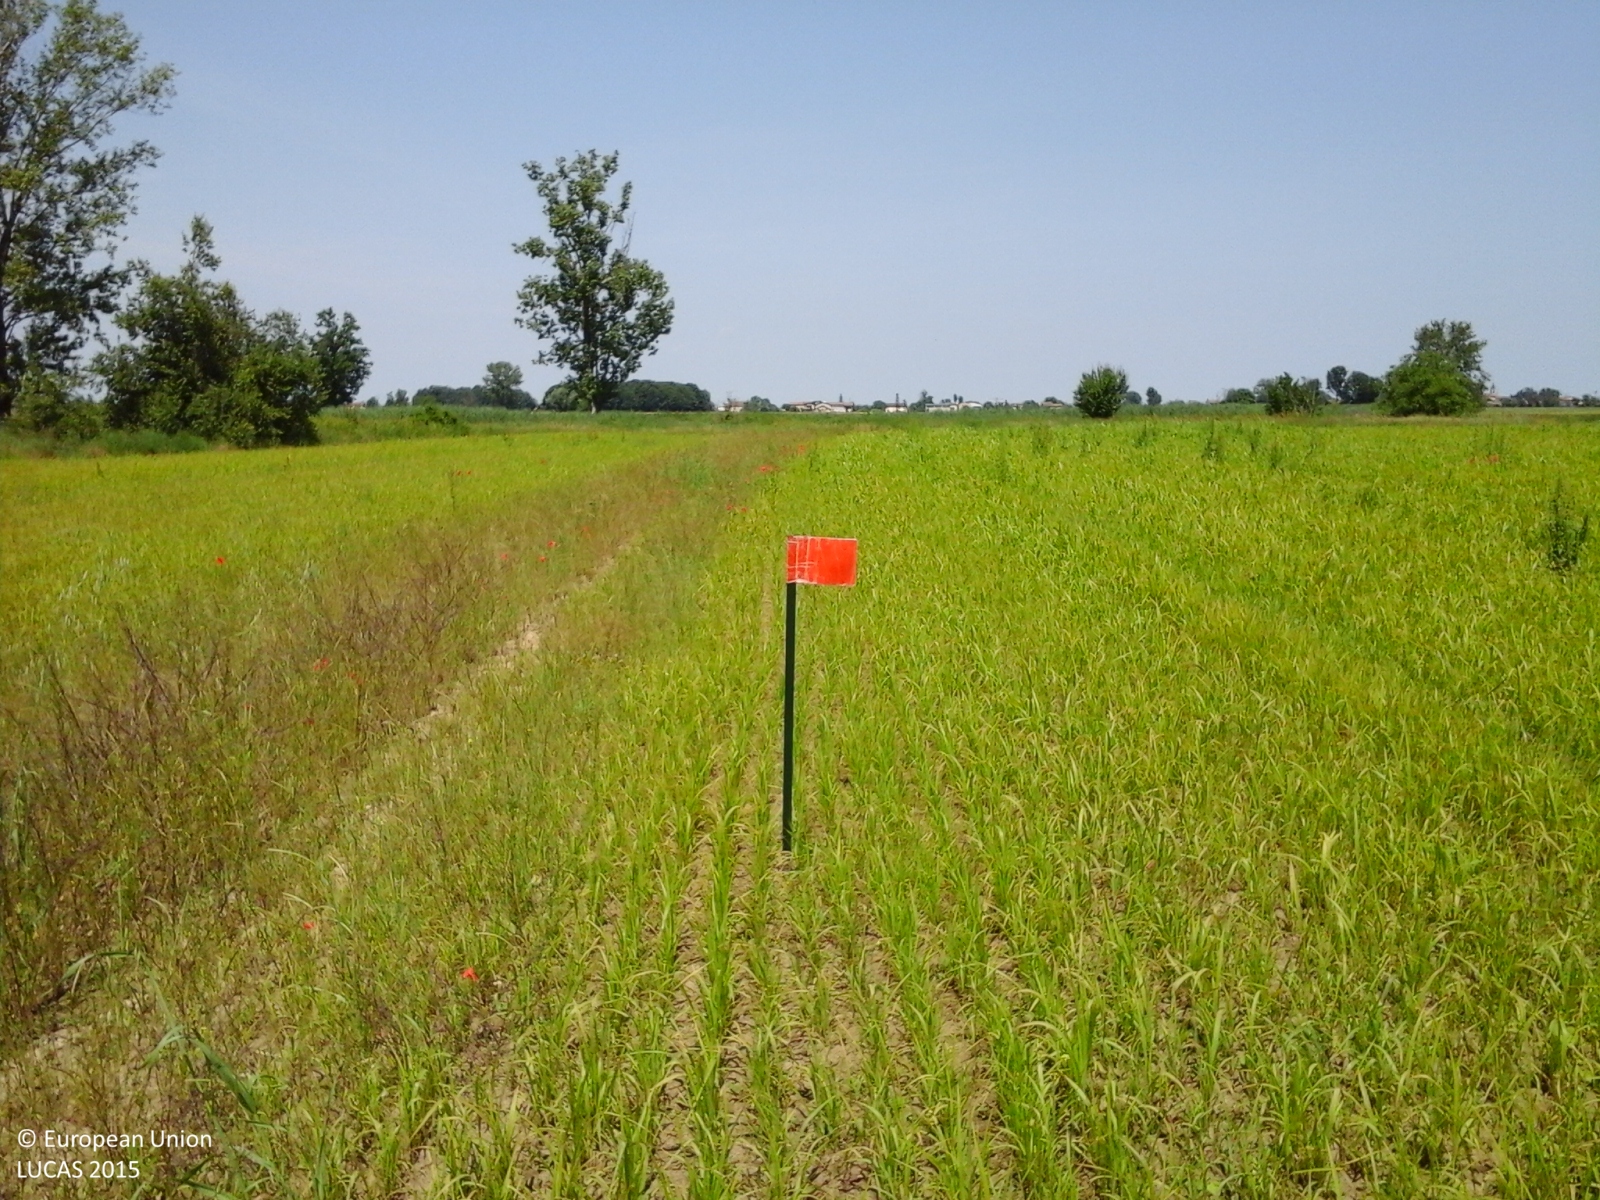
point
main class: Cropland
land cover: Temporary grasslands
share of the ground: > 75 %
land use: Agriculture (excluding fallow land and kitchen gardens)
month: May
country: IT
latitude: 44.8359
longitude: 10.5681
